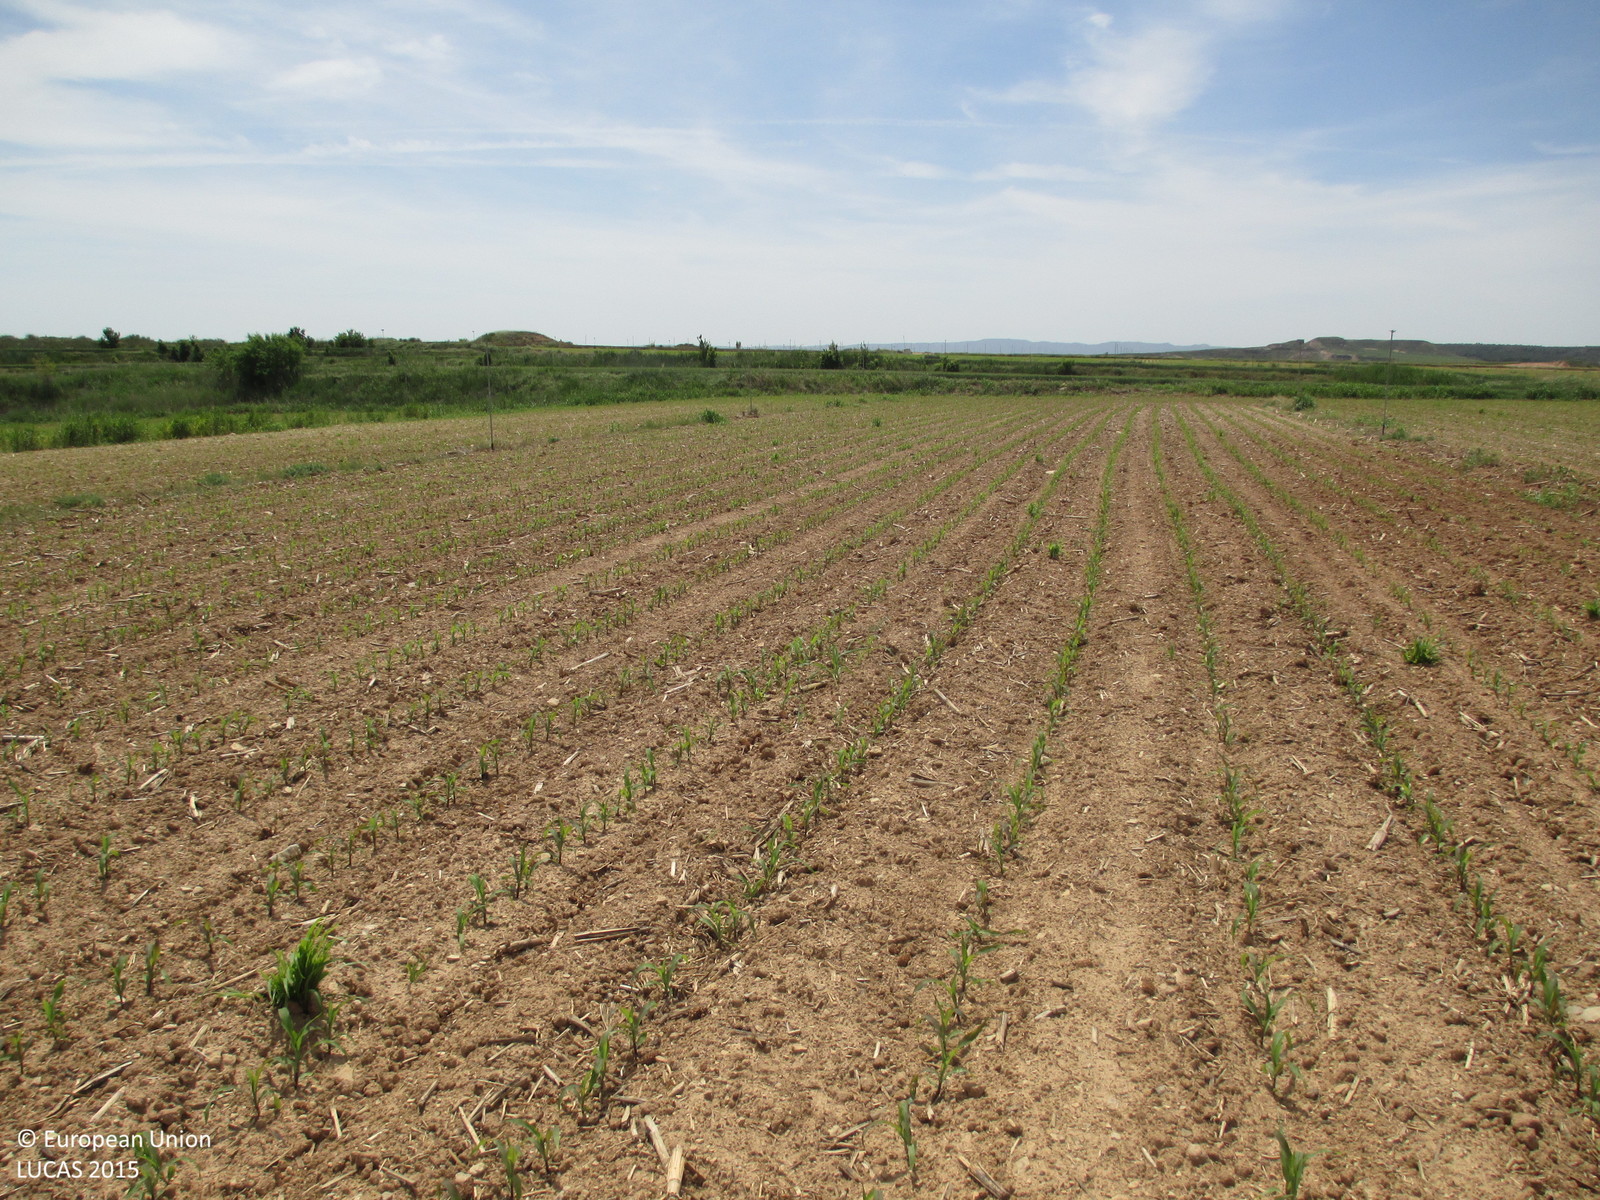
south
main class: Cropland
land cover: Maize
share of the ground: < 10 %
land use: Agriculture (excluding fallow land and kitchen gardens)
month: May
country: ES
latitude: 41.8682
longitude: -0.3449
